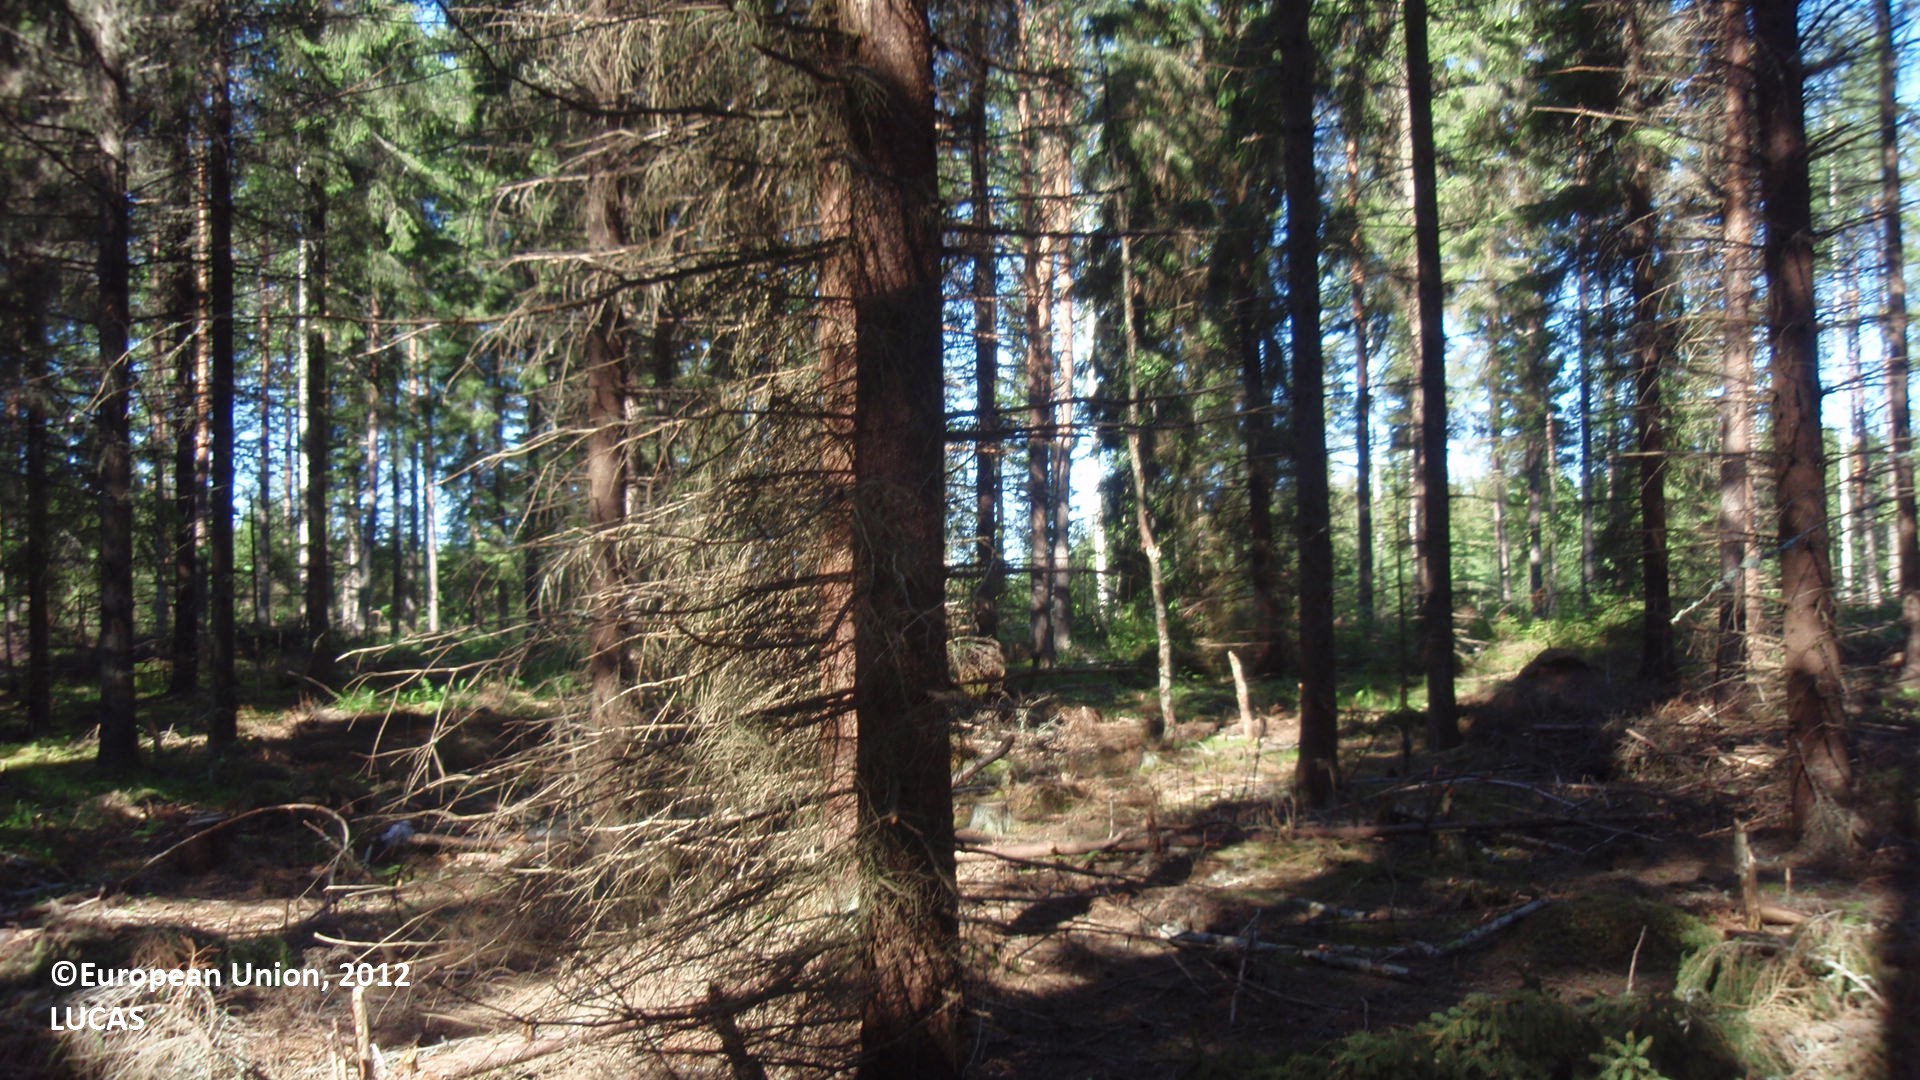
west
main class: Woodland
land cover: Spruce dominated coniferous woodland
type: boreal forest
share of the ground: 50 - 75 %
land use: Forestry
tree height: > 5 m
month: June
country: FI
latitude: 61.3978
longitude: 26.8040
